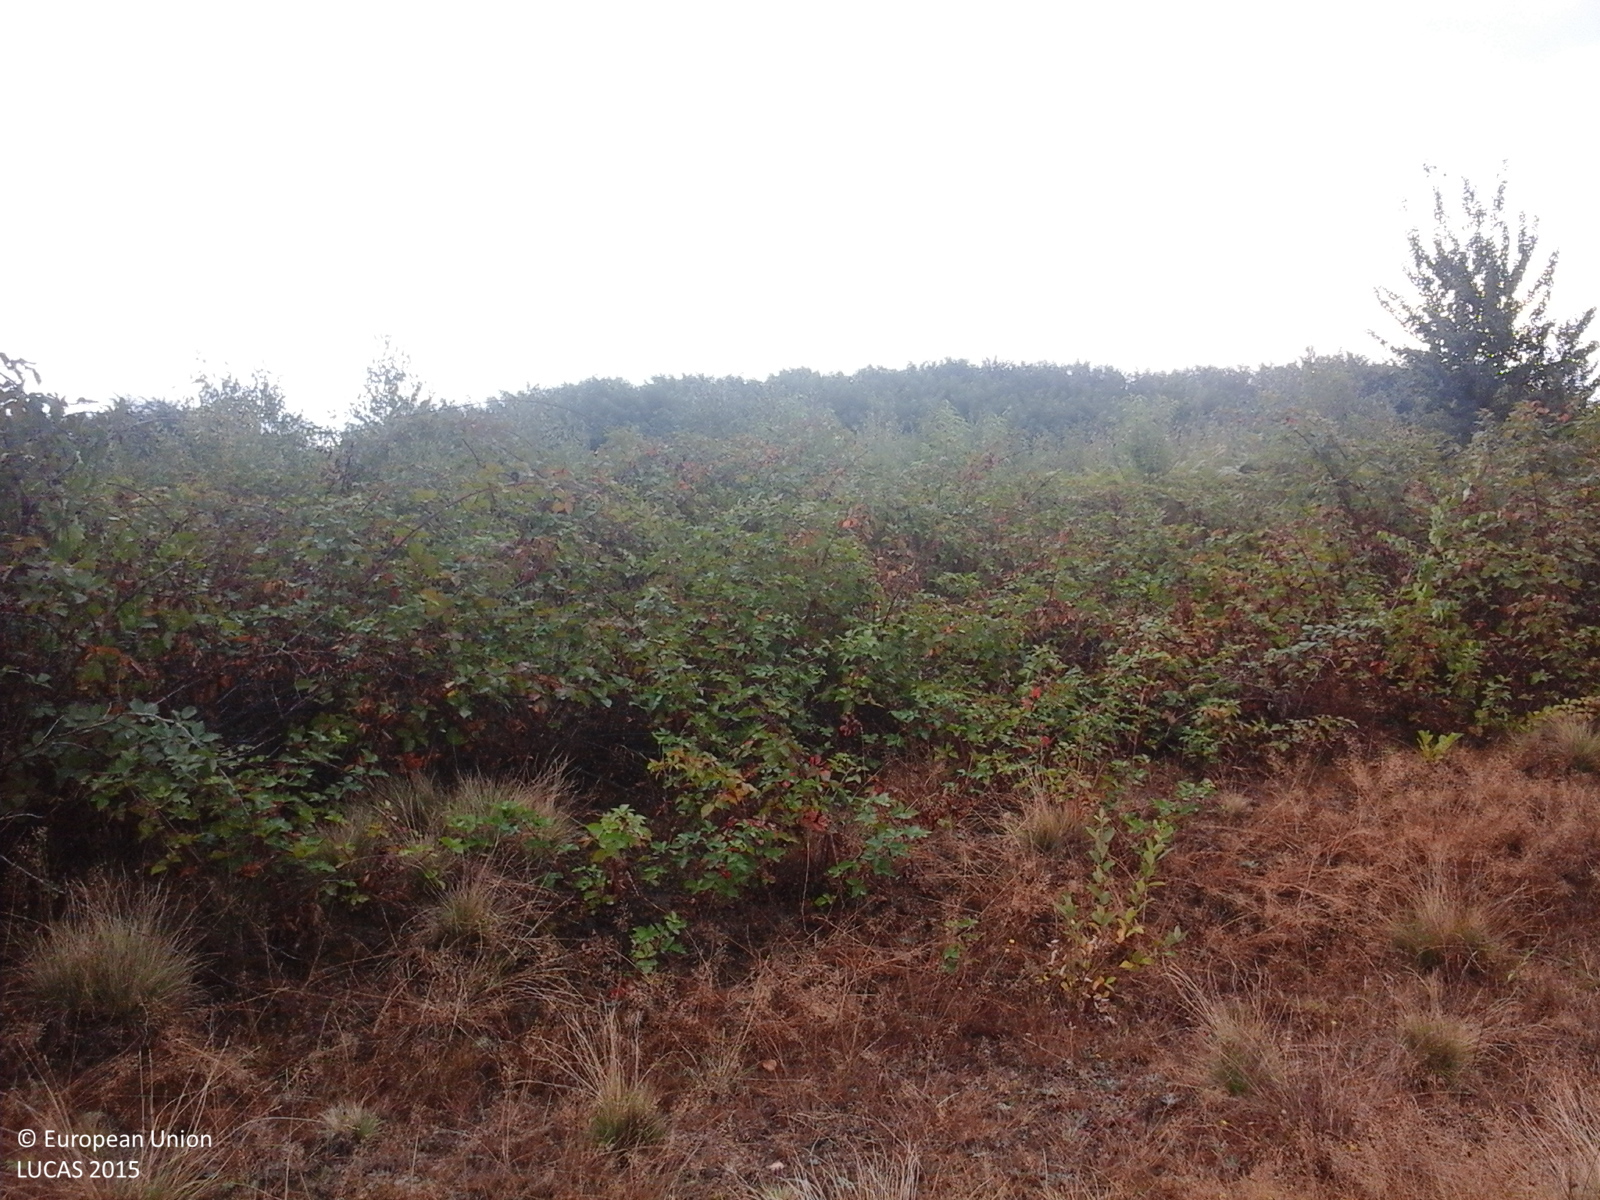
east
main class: Shrubland
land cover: Shrubland with sparse tree cover
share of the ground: > 75 %
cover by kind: shrubs 95 %, broadleaved forest trees 5 %
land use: Semi-natural and natural areas not in use
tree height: < 5 m
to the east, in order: Shrubland with sparse tree cover; Grass margins; Tracks; Grass margins; Shrubland with sparse tree cover; Broadleaved woodland; Spontaneously vegetated surfaces
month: September
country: RO
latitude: 47.6332
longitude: 23.5846
